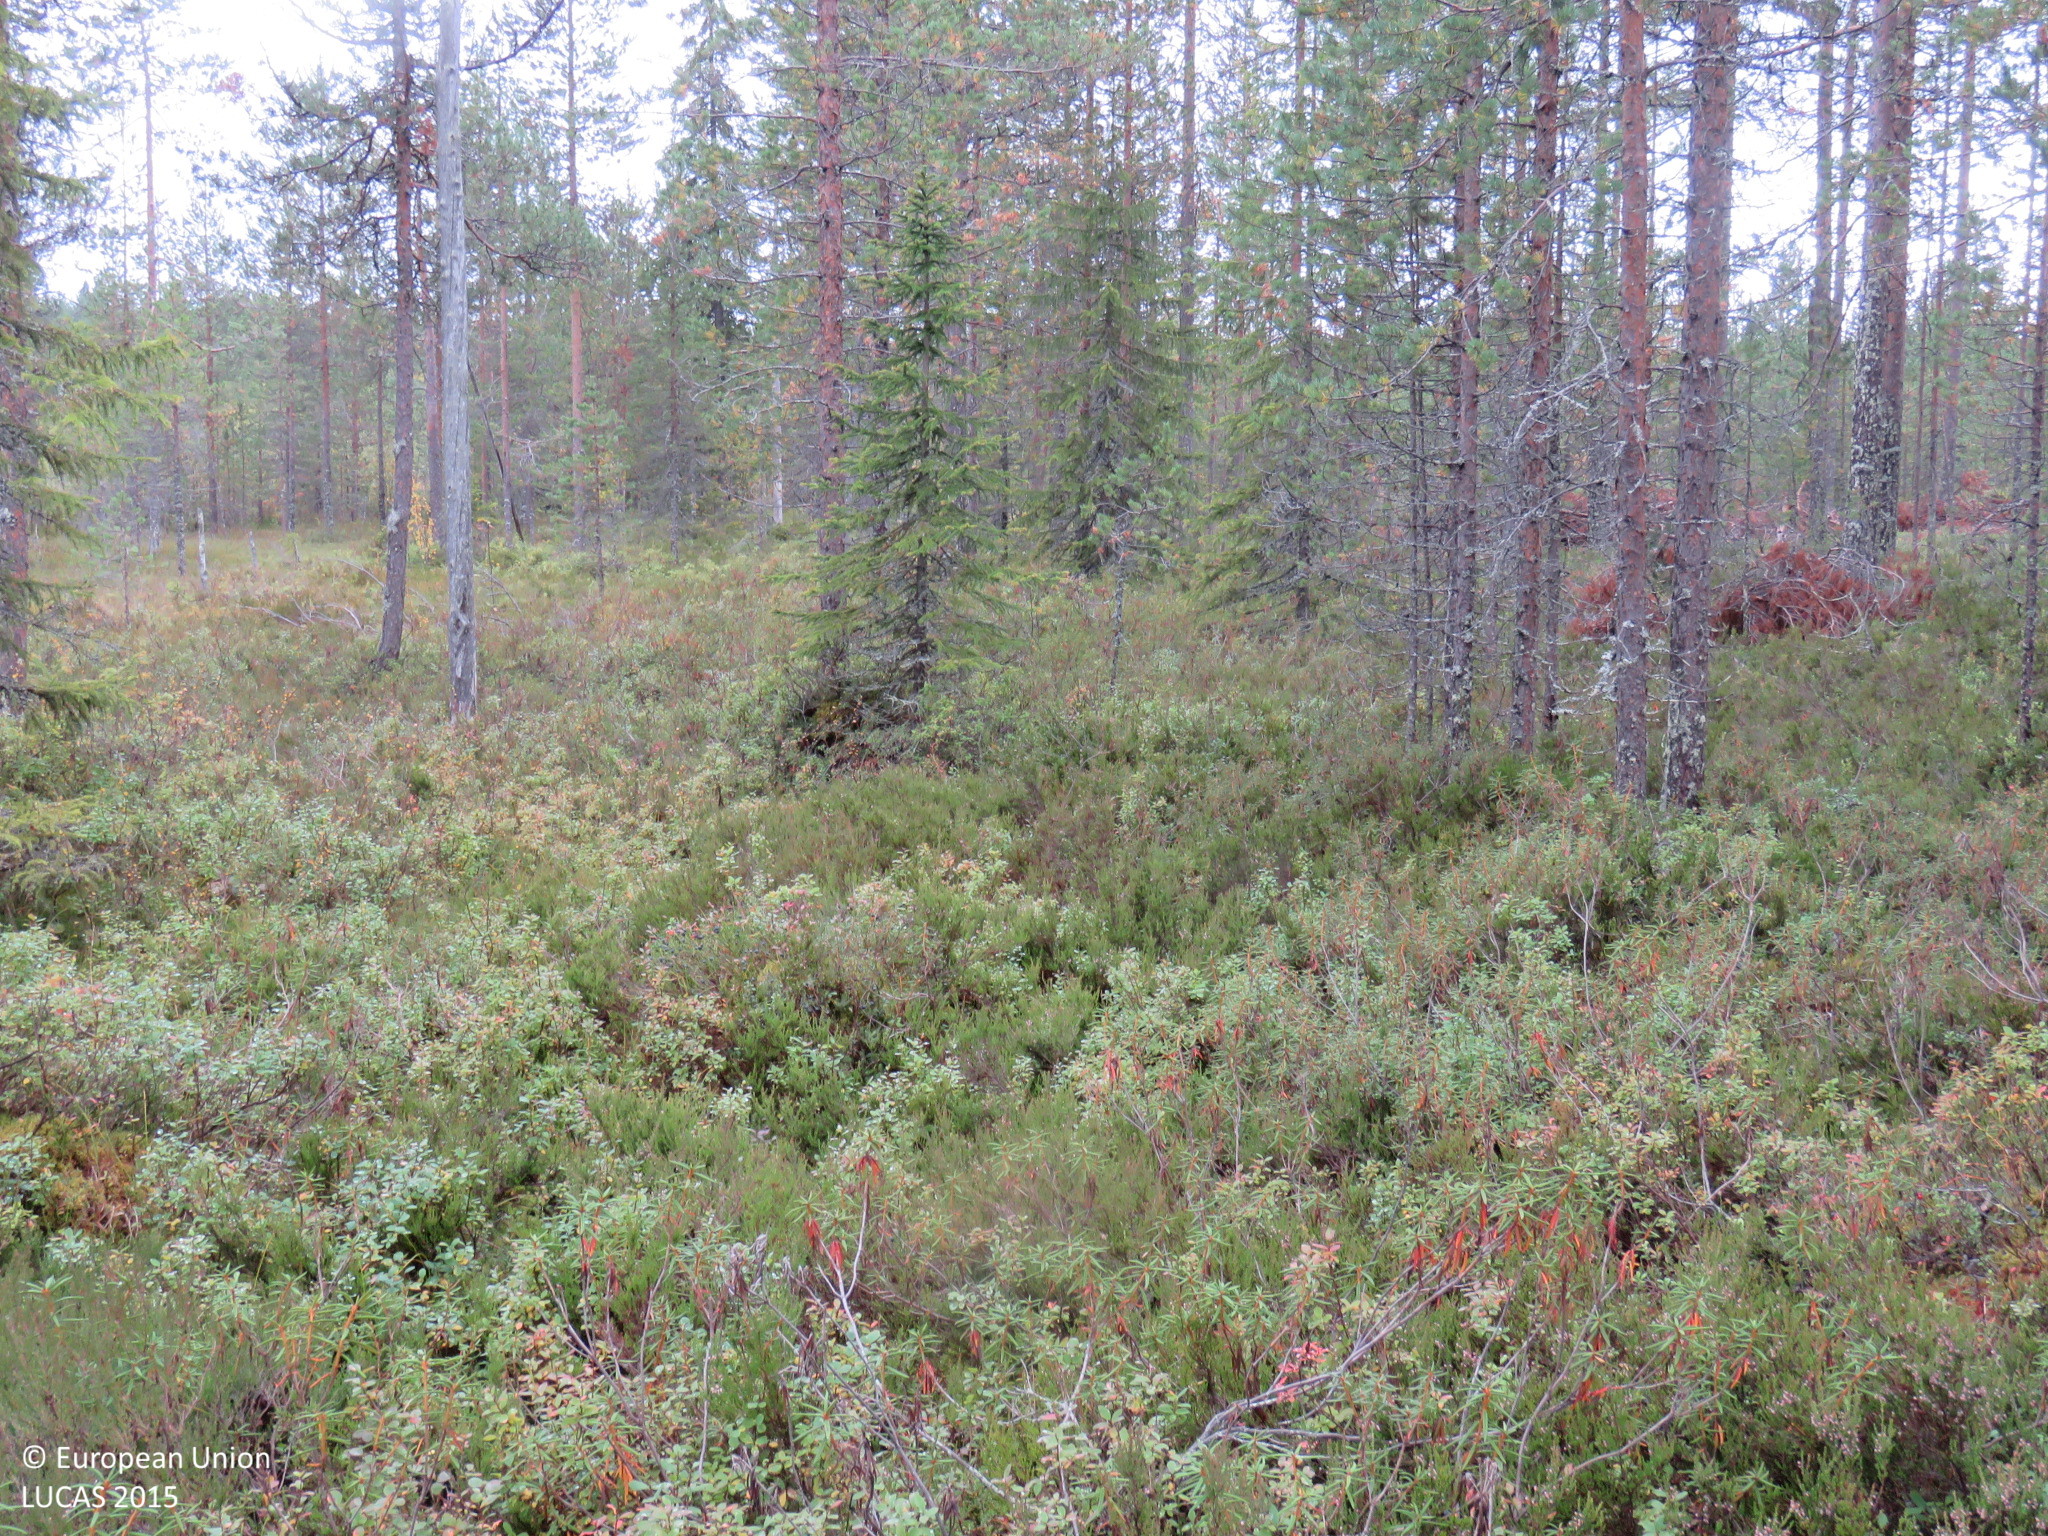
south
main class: Woodland
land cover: Pine dominated coniferous woodland
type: boreal forest
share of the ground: 50 - 75 %
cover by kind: coniferous forest trees 65 %, shrubs 30 %, lichens and mosses 5 %
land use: Forestry
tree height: > 5 m
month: September
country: FI
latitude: 65.1828
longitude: 27.4933
